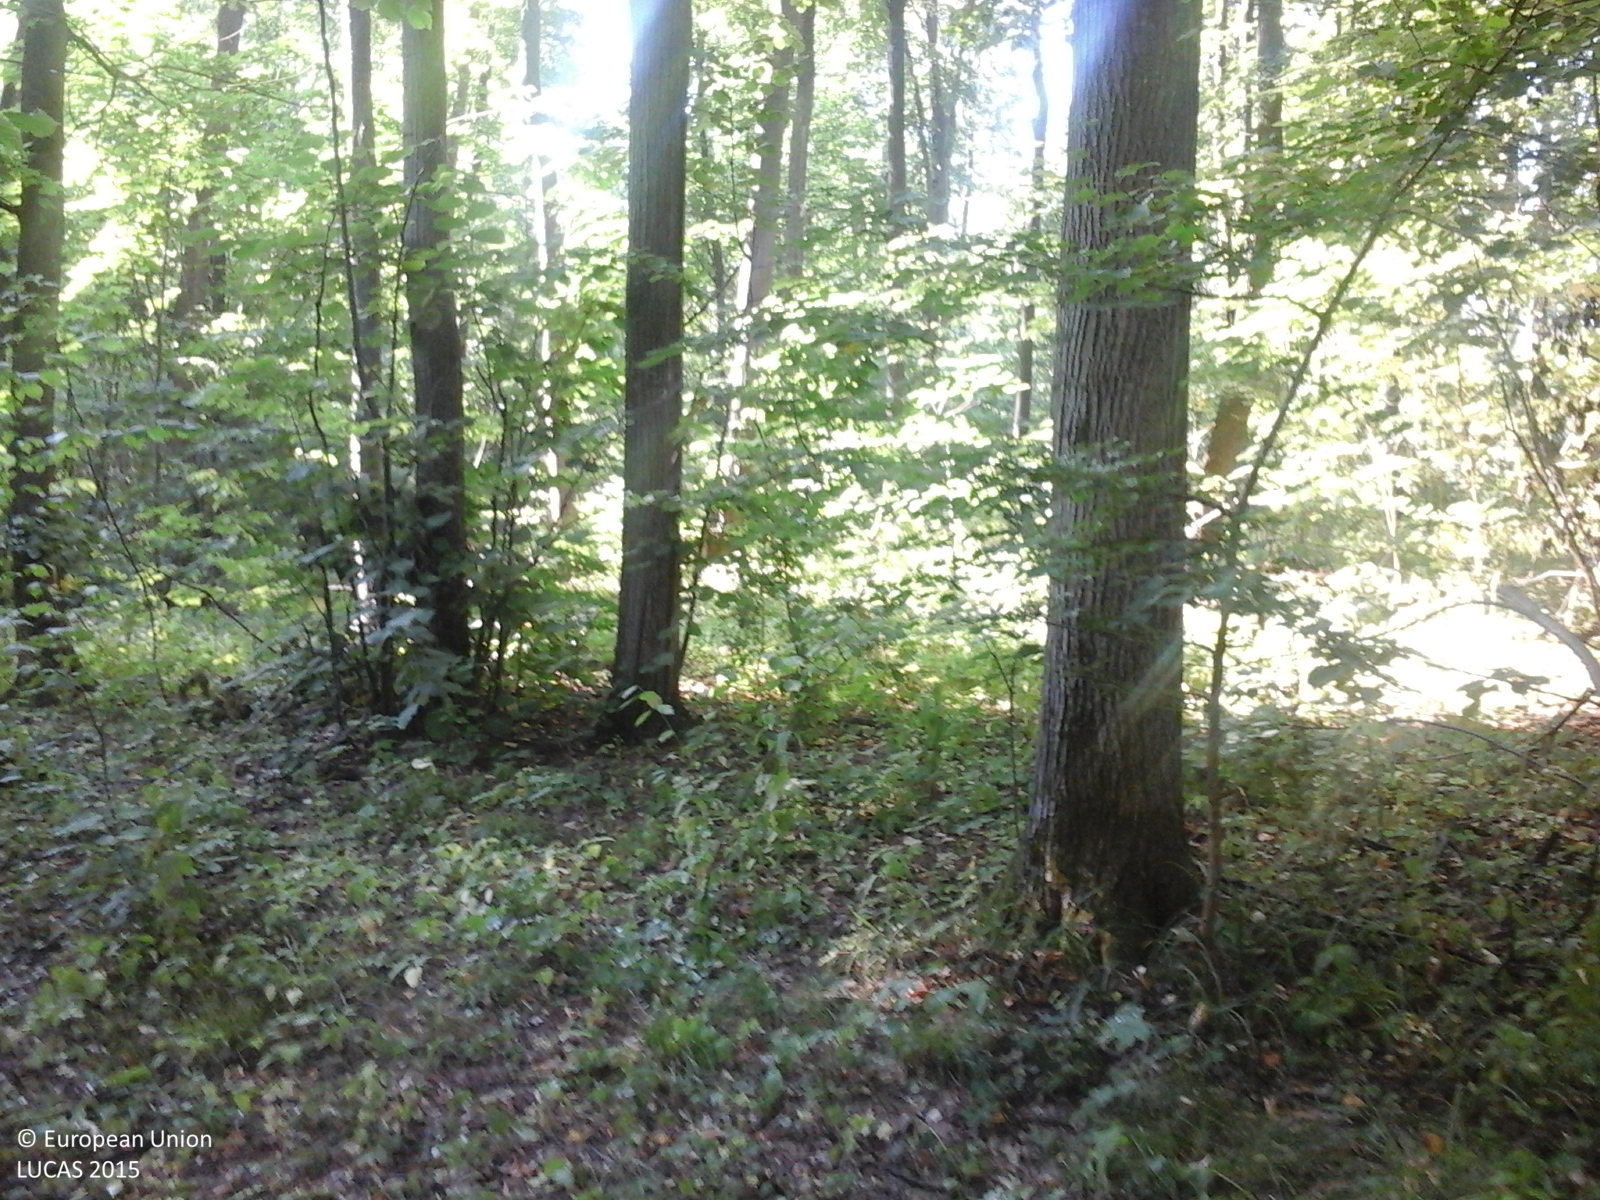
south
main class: Woodland
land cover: Broadleaved woodland
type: mesophytic deciduous forest
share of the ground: > 75 %
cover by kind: broadleaved forest trees 90 %, herbaceous plants 10 %
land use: Forestry
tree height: > 5 m
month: July
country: RO
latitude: 46.0540
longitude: 27.2778
